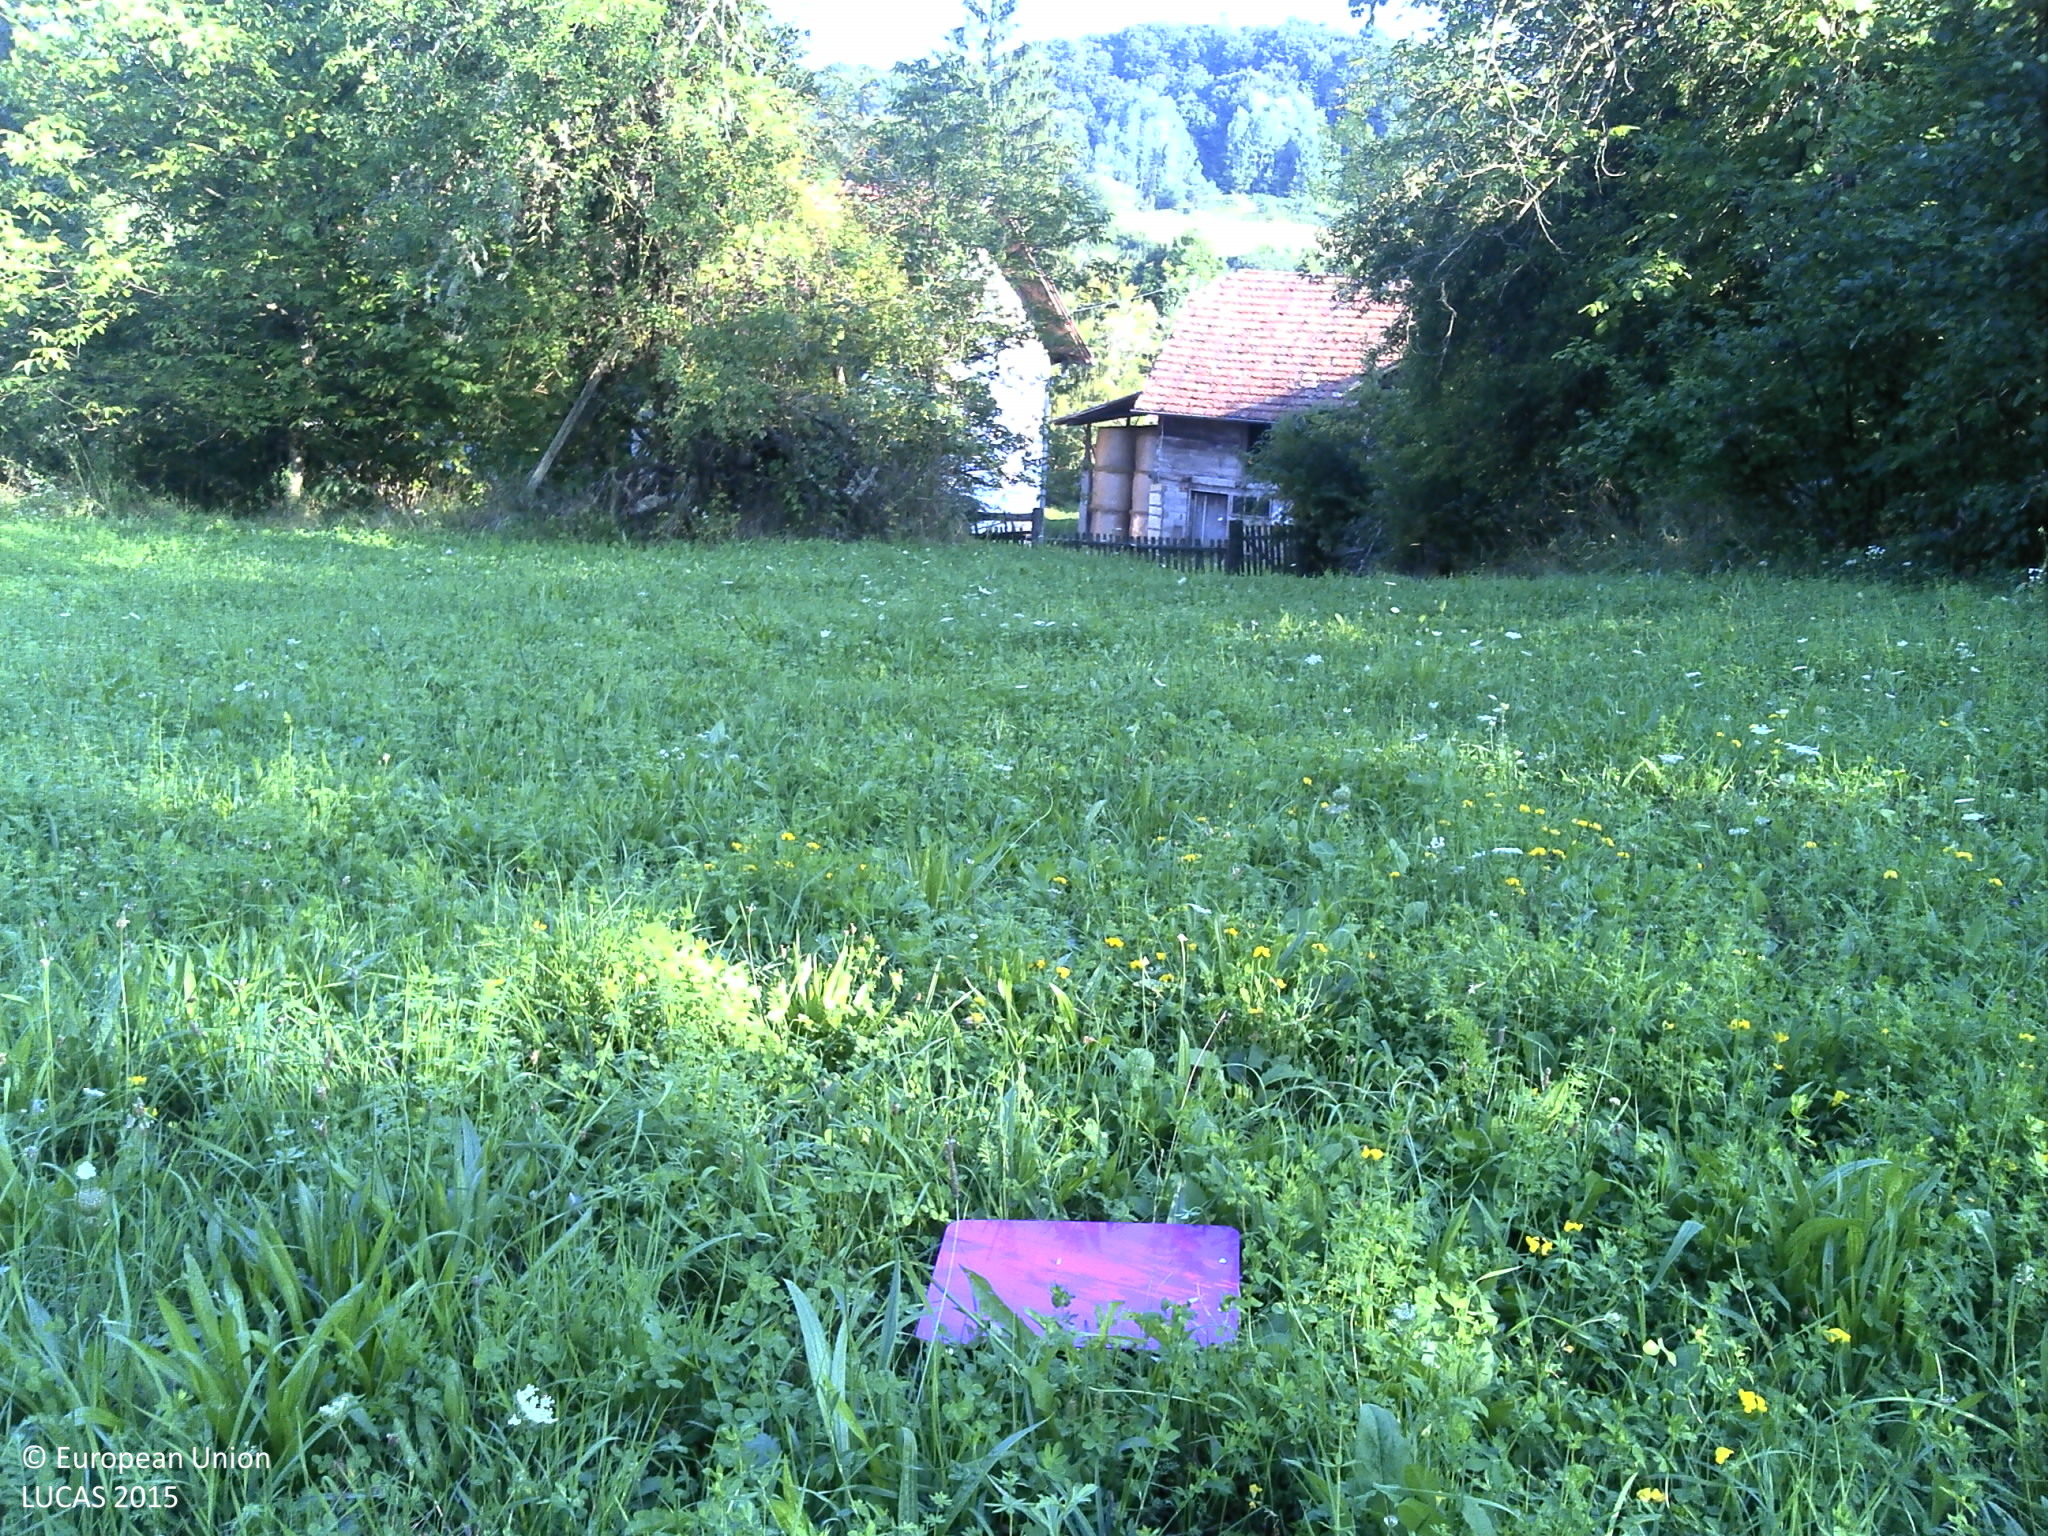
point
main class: Grassland
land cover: Spontaneously vegetated surfaces
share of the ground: > 75 %
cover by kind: herbaceous plants 100 %
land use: Semi-natural and natural areas not in use
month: August
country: HR
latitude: 45.1360
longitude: 16.2909
